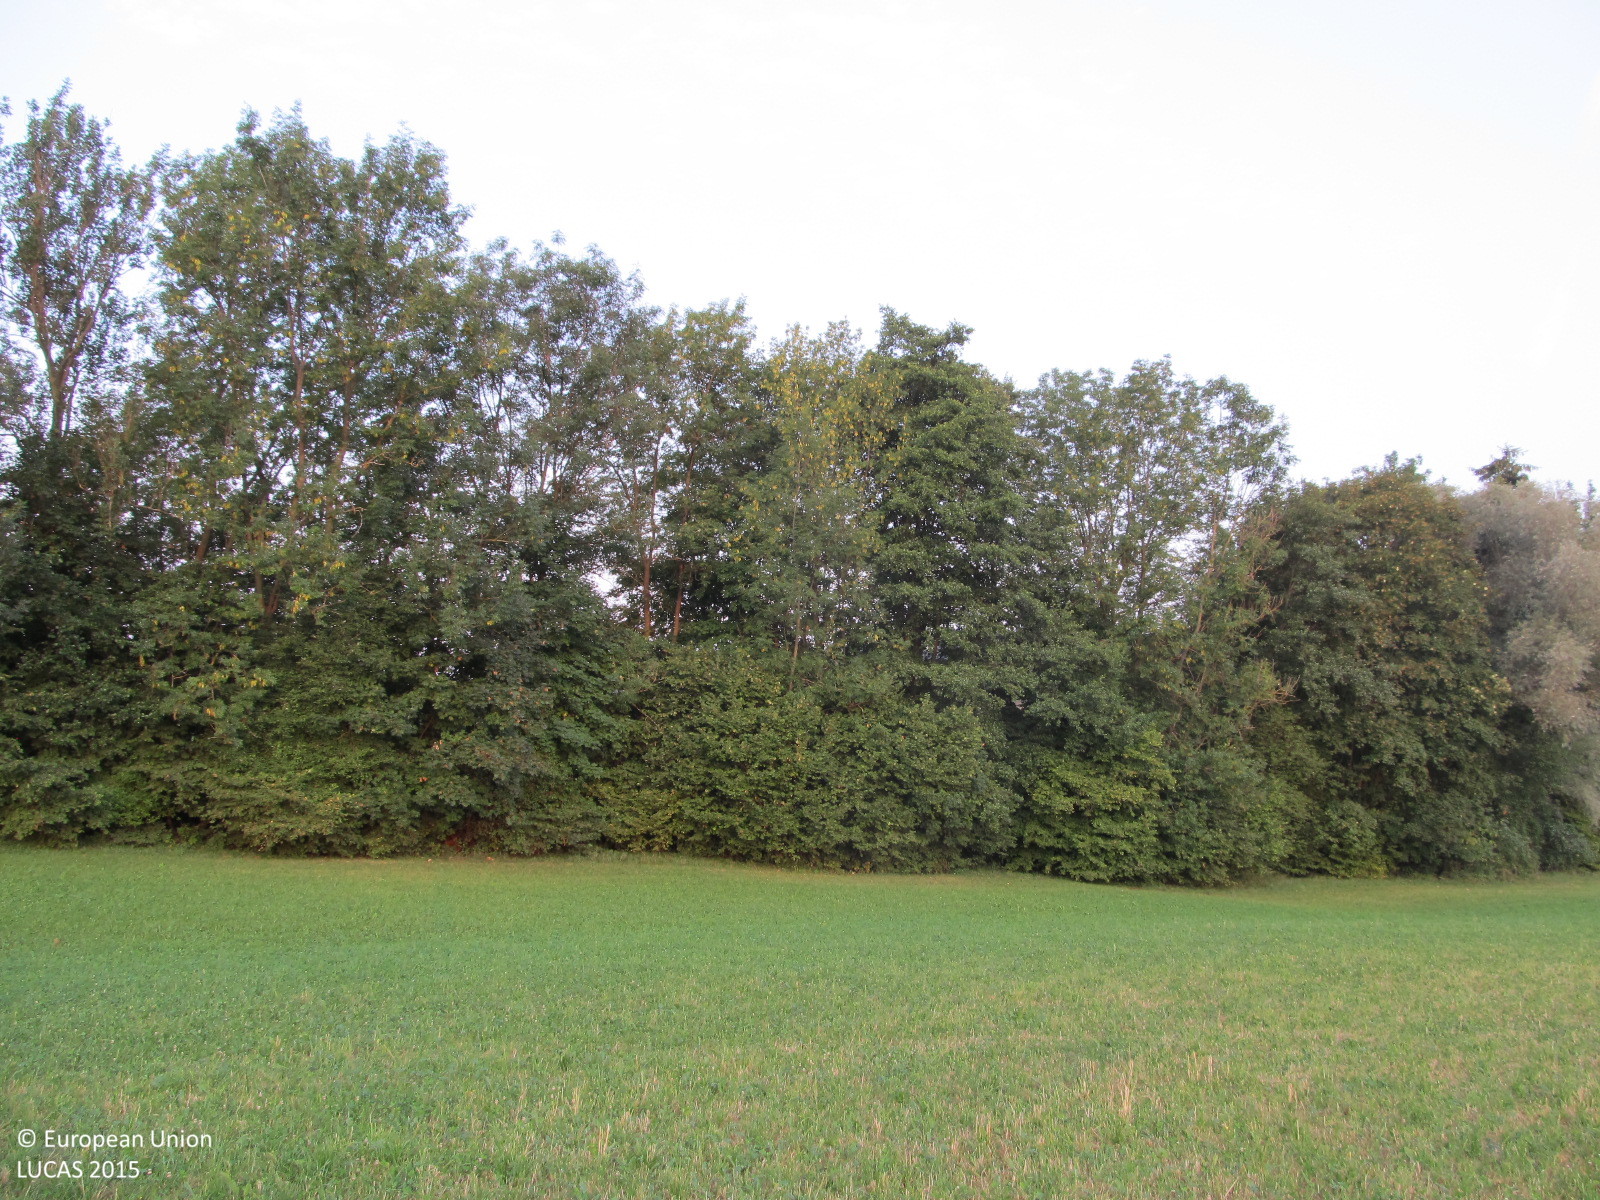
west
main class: Grassland
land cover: Grassland without tree/shrub cover
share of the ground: > 75 %
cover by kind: herbaceous plants 100 %
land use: Agriculture (excluding fallow land and kitchen gardens)
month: August
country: AT
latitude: 48.0573
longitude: 15.3552
